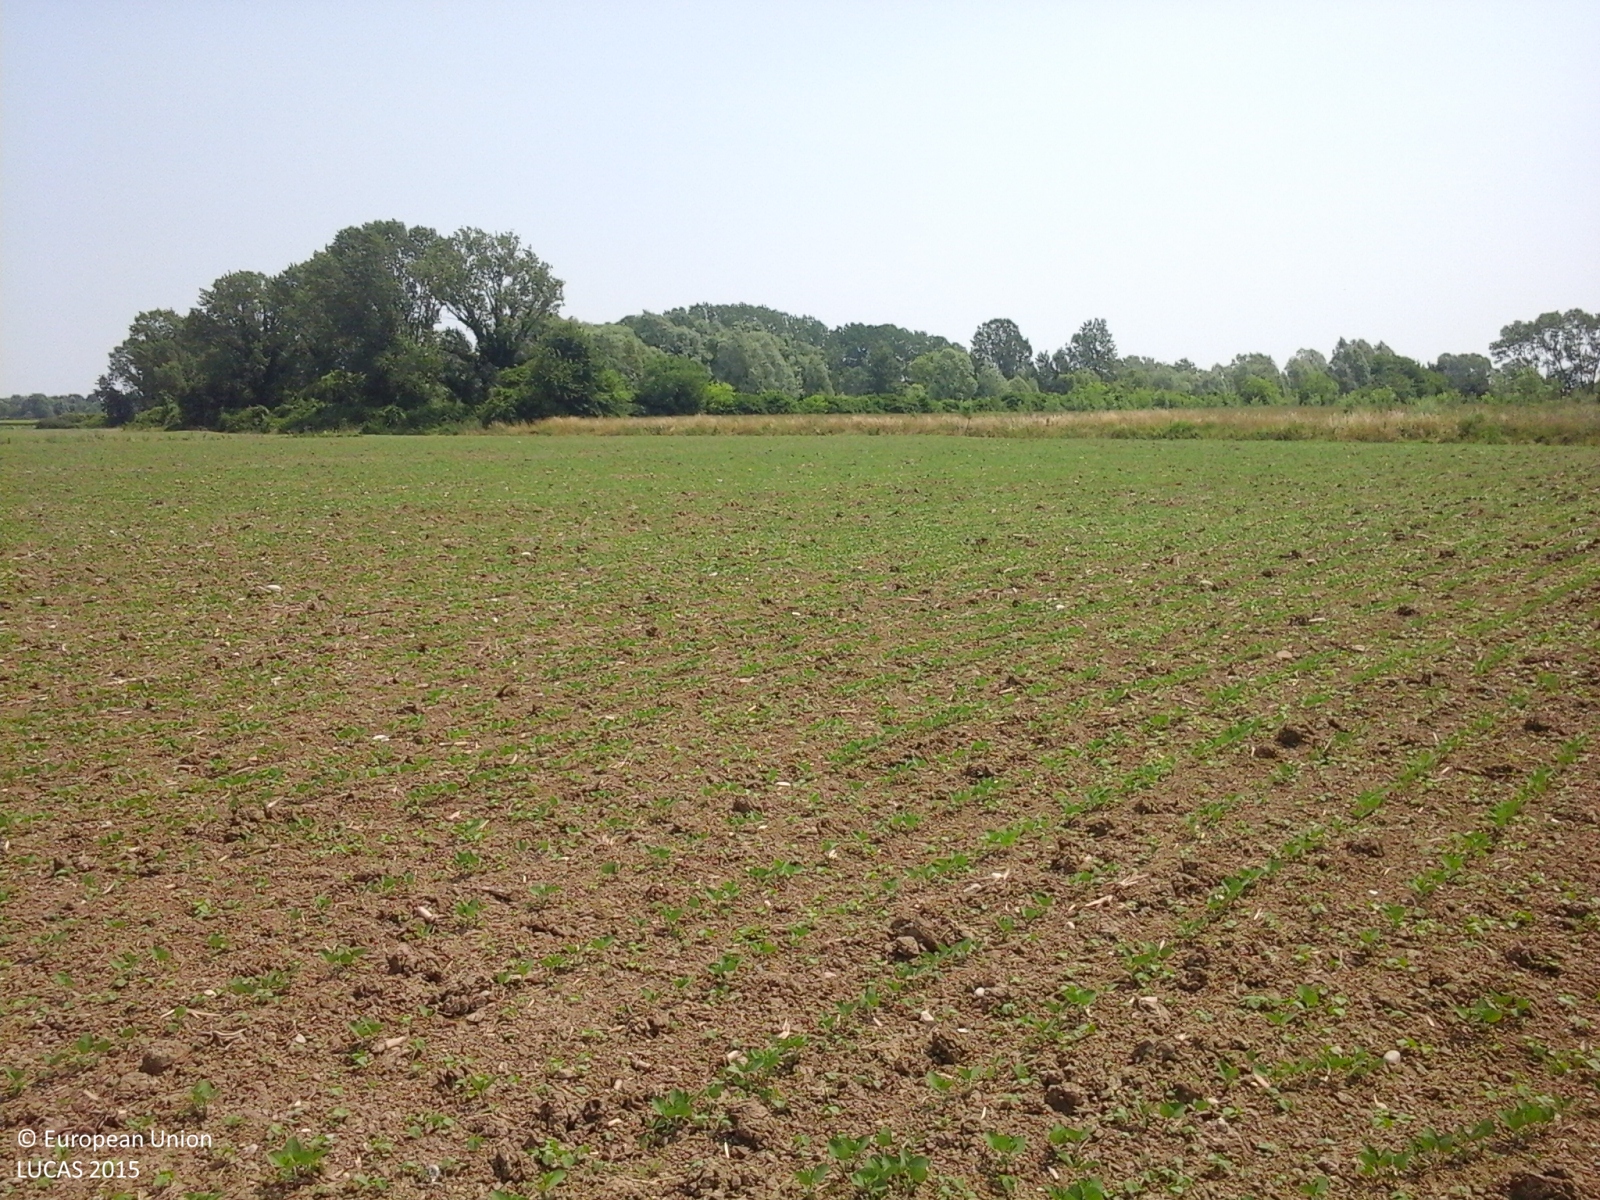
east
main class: Grassland
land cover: Grassland with sparse tree/shrub cover
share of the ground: > 75 %
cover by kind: herbaceous plants 95 %, broadleaved forest trees 5 %
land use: Agriculture (excluding fallow land and kitchen gardens)
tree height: < 5 m
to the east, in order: Grassland with sparse tree/shrub cover; Ditches and canals; Grassland without tree/shrub cover; Soya; Tracks; Grassland without tree/shrub cover; Ditches and canals; Grassland without tree/shrub cover; Lines of trees; Ditches and canals; Lines of trees; Grassland without tree/shrub cover; Broadleaved woodland
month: June
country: IT
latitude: 45.6023
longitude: 12.4452
